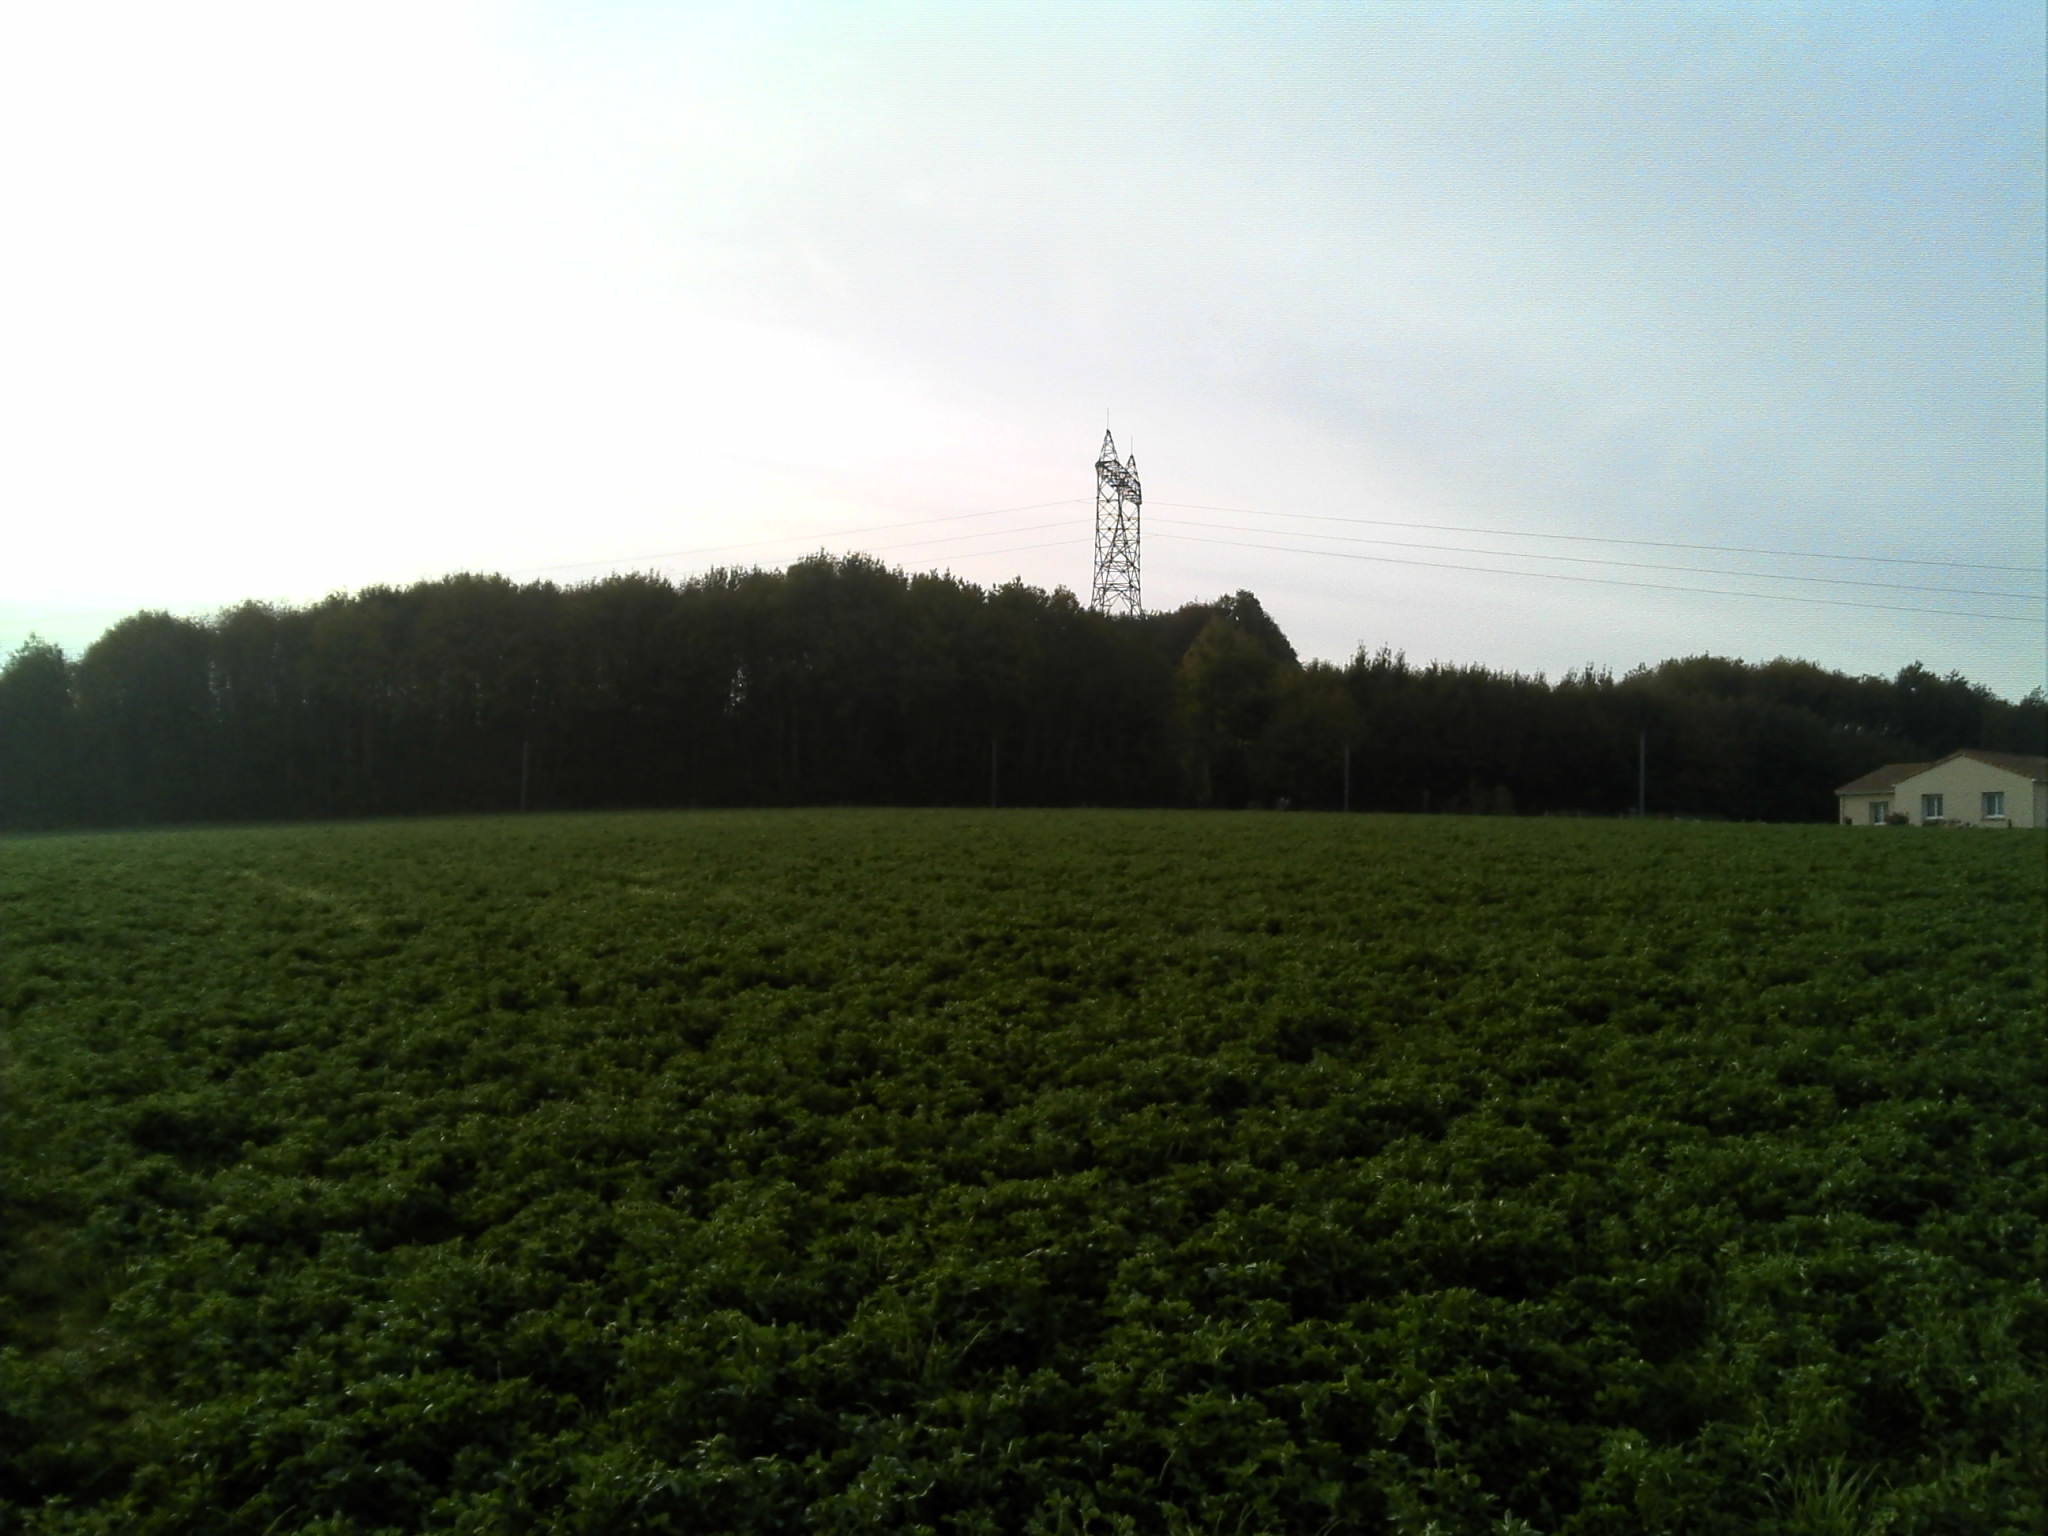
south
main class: Cropland
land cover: Lucerne
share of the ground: > 75 %
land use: Agriculture (excluding fallow land and kitchen gardens)
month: October
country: FR
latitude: 47.2777
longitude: -0.9412
